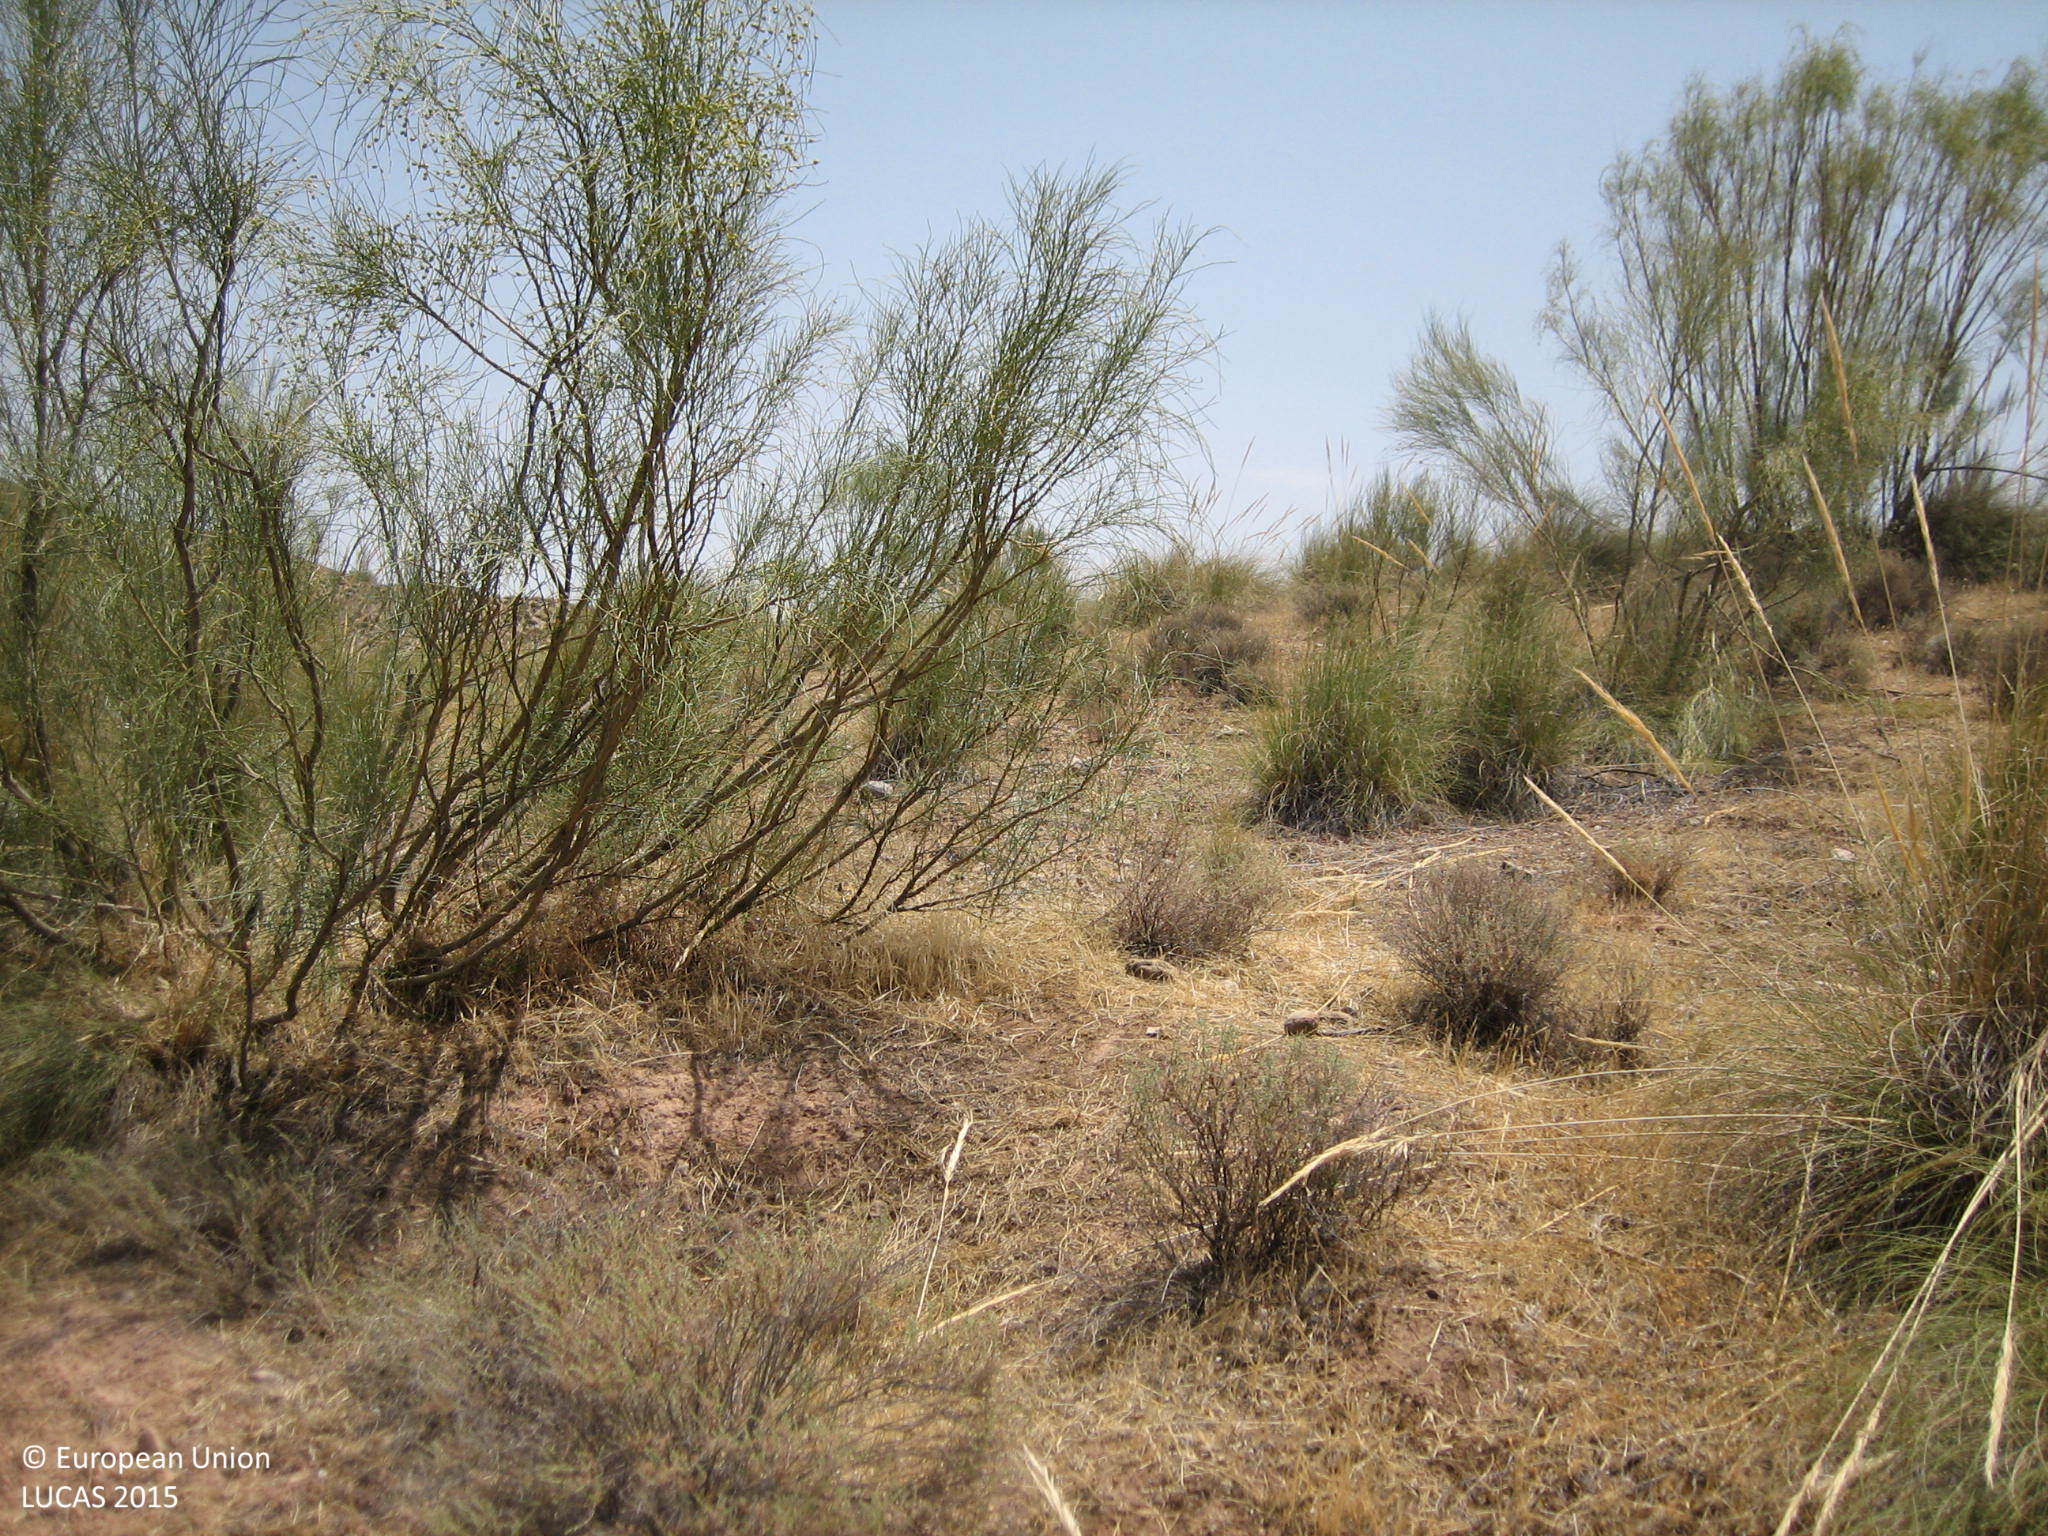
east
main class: Grassland
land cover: Grassland without tree/shrub cover
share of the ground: > 75 %
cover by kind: herbaceous plants 80 %, consolidated bare surface 20 %
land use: Agriculture (excluding fallow land and kitchen gardens)
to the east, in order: Grassland without tree/shrub cover; Other bare soil; Shrubland without tree cover; Tracks; Shrubland without tree cover
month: July
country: ES
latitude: 37.6917
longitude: -3.0224
